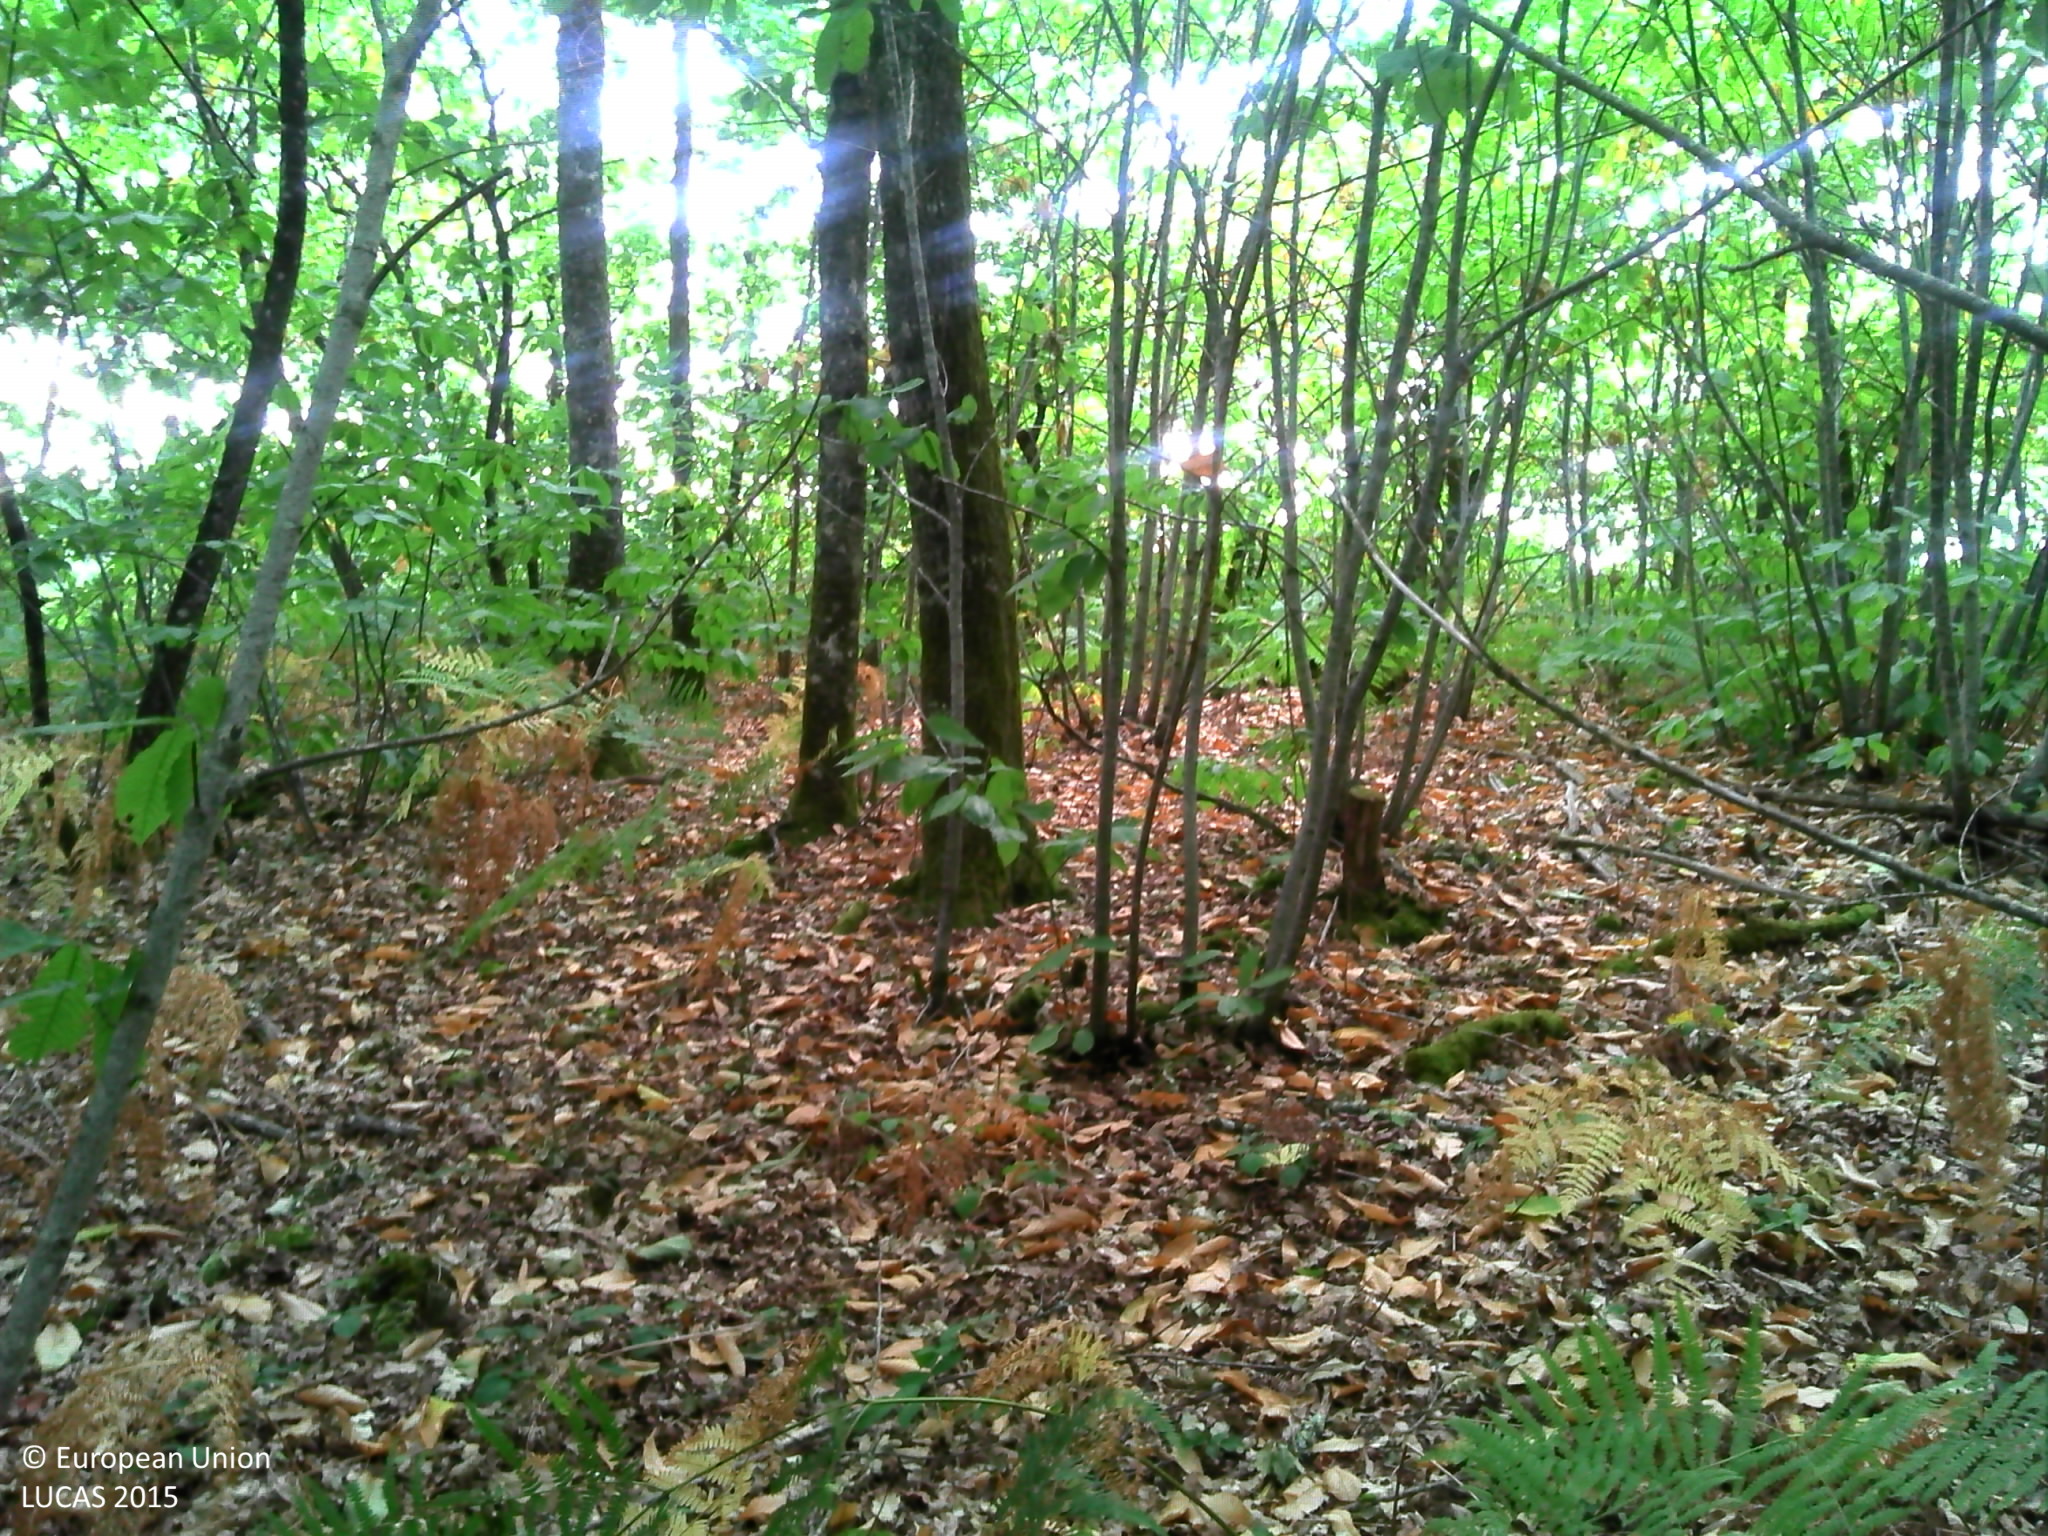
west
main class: Woodland
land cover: Broadleaved woodland
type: mesophytic deciduous forest
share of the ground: > 75 %
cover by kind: broadleaved forest trees 70 %, herbaceous plants 10 %, lichens and mosses 10 %, unconsolidated bare surface 10 %
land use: Forestry
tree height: > 5 m
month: July
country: FR
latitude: 45.6292
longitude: 0.6107
